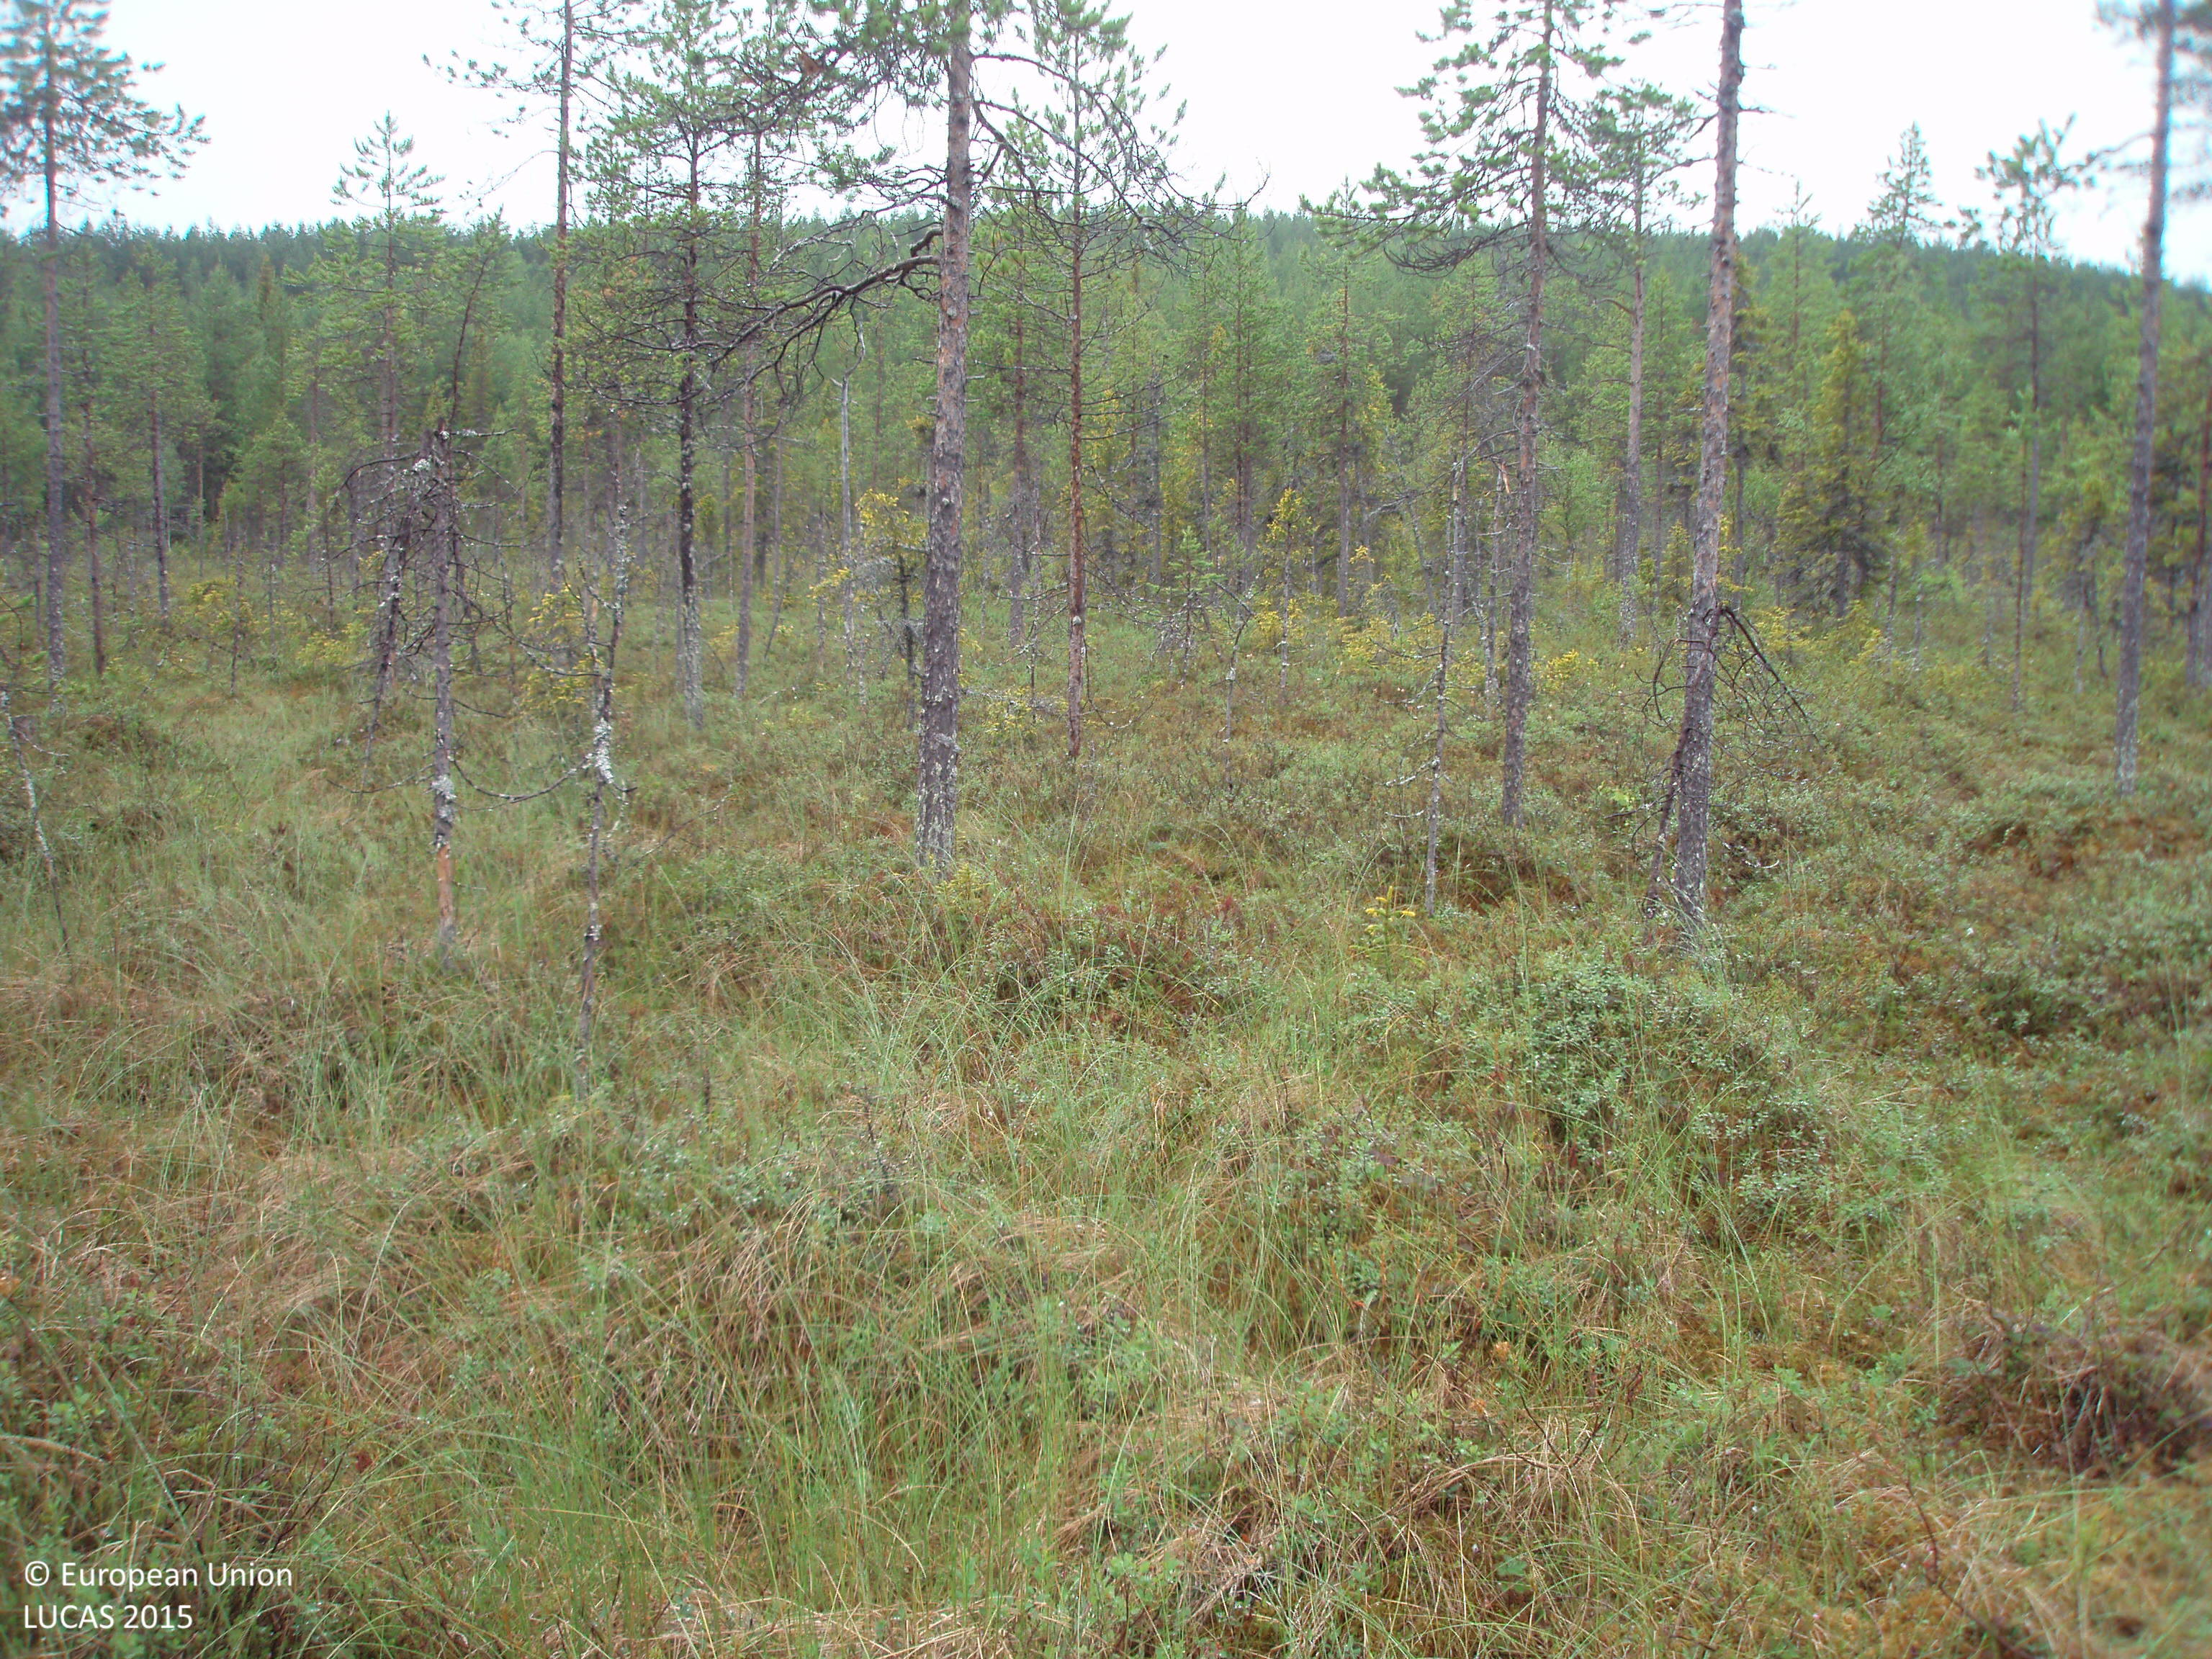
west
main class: Woodland
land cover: Pine dominated coniferous woodland
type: mire and swamp forests
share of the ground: 10 - 25 %
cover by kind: shrubs 70 %, coniferous forest trees 10 %, herbaceous plants 10 %, lichens and mosses 10 %
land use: Semi-natural and natural areas not in use
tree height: > 5 m
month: July
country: FI
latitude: 66.7806
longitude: 27.9199
